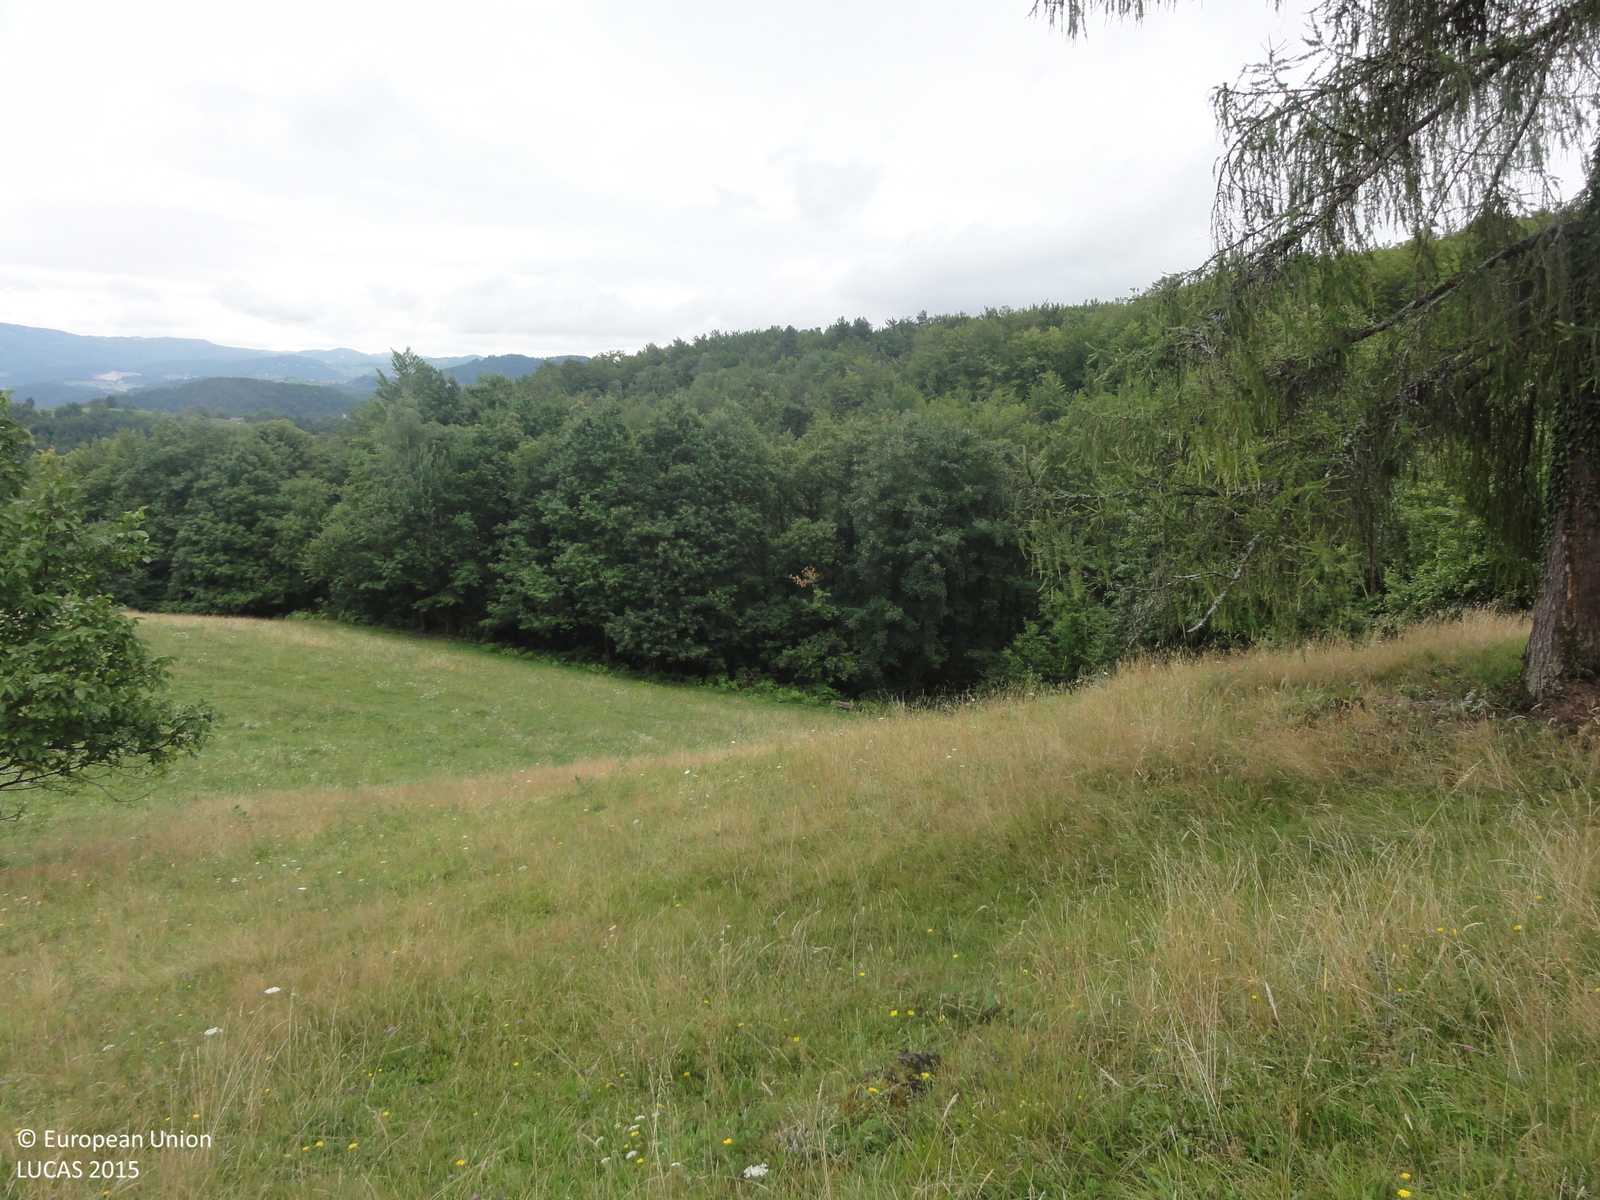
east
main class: Grassland
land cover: Grassland without tree/shrub cover
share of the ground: > 75 %
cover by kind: herbaceous plants 100 %
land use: Agriculture (excluding fallow land and kitchen gardens)
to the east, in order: Grassland without tree/shrub cover; Fences; Broadleaved woodland; Rivers and streams; Broadleaved woodland
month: July
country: SI
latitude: 46.0095
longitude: 14.7880
